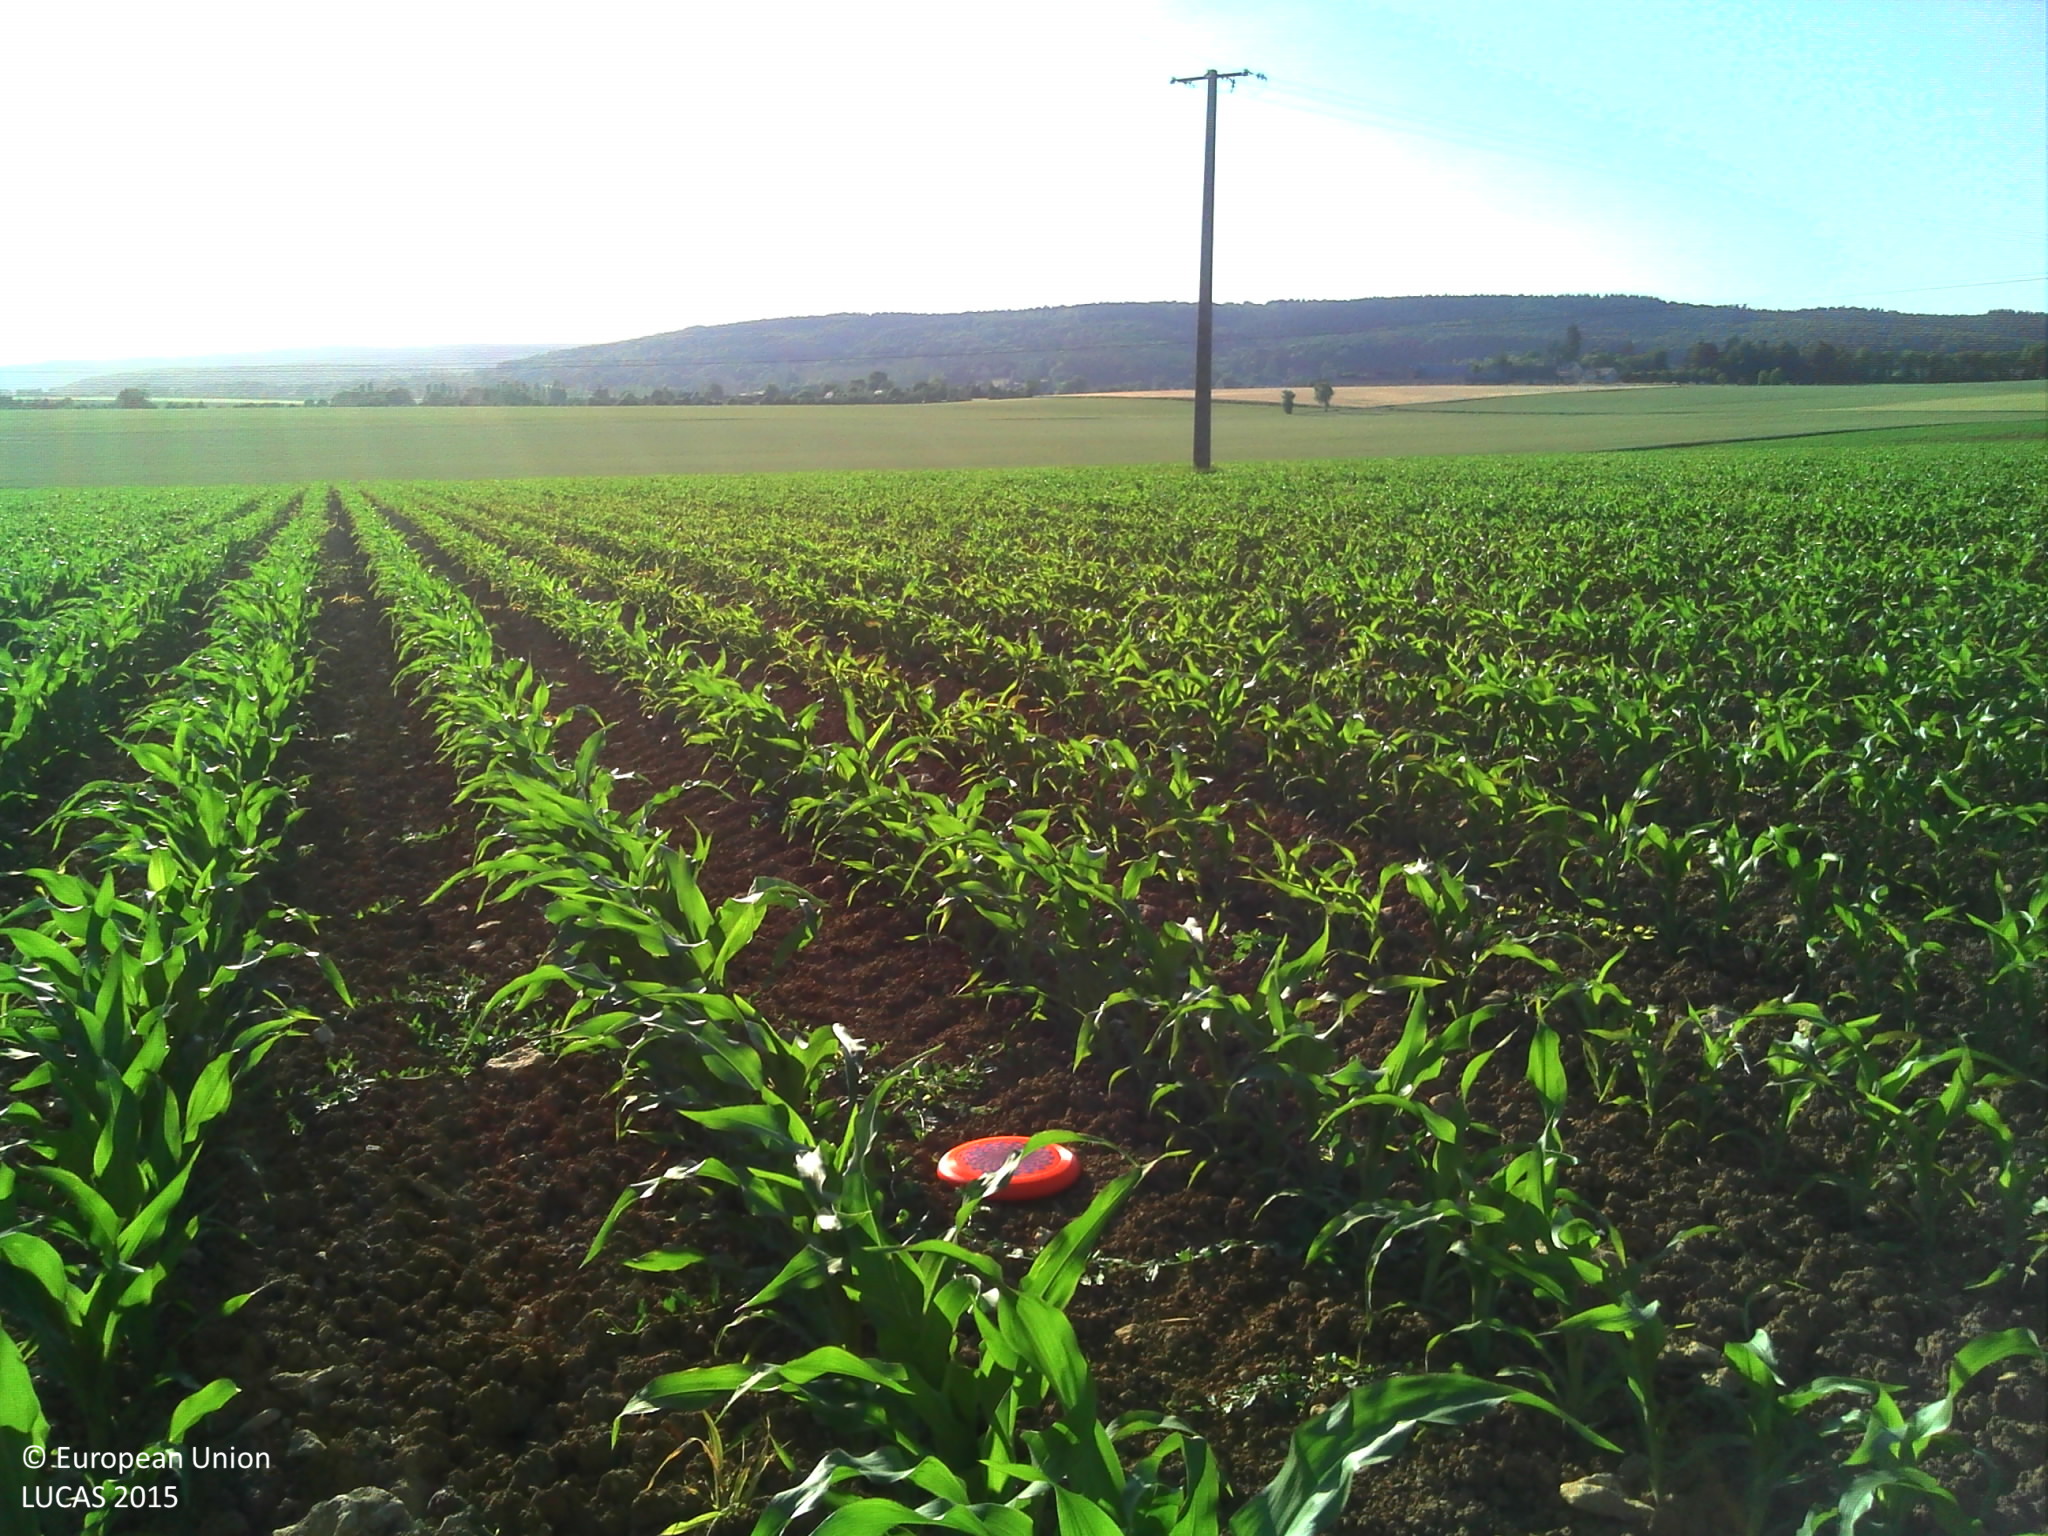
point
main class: Cropland
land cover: Maize
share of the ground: 25 - 50 %
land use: Agriculture (excluding fallow land and kitchen gardens)
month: June
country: FR
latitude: 48.4846
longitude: 0.1085
